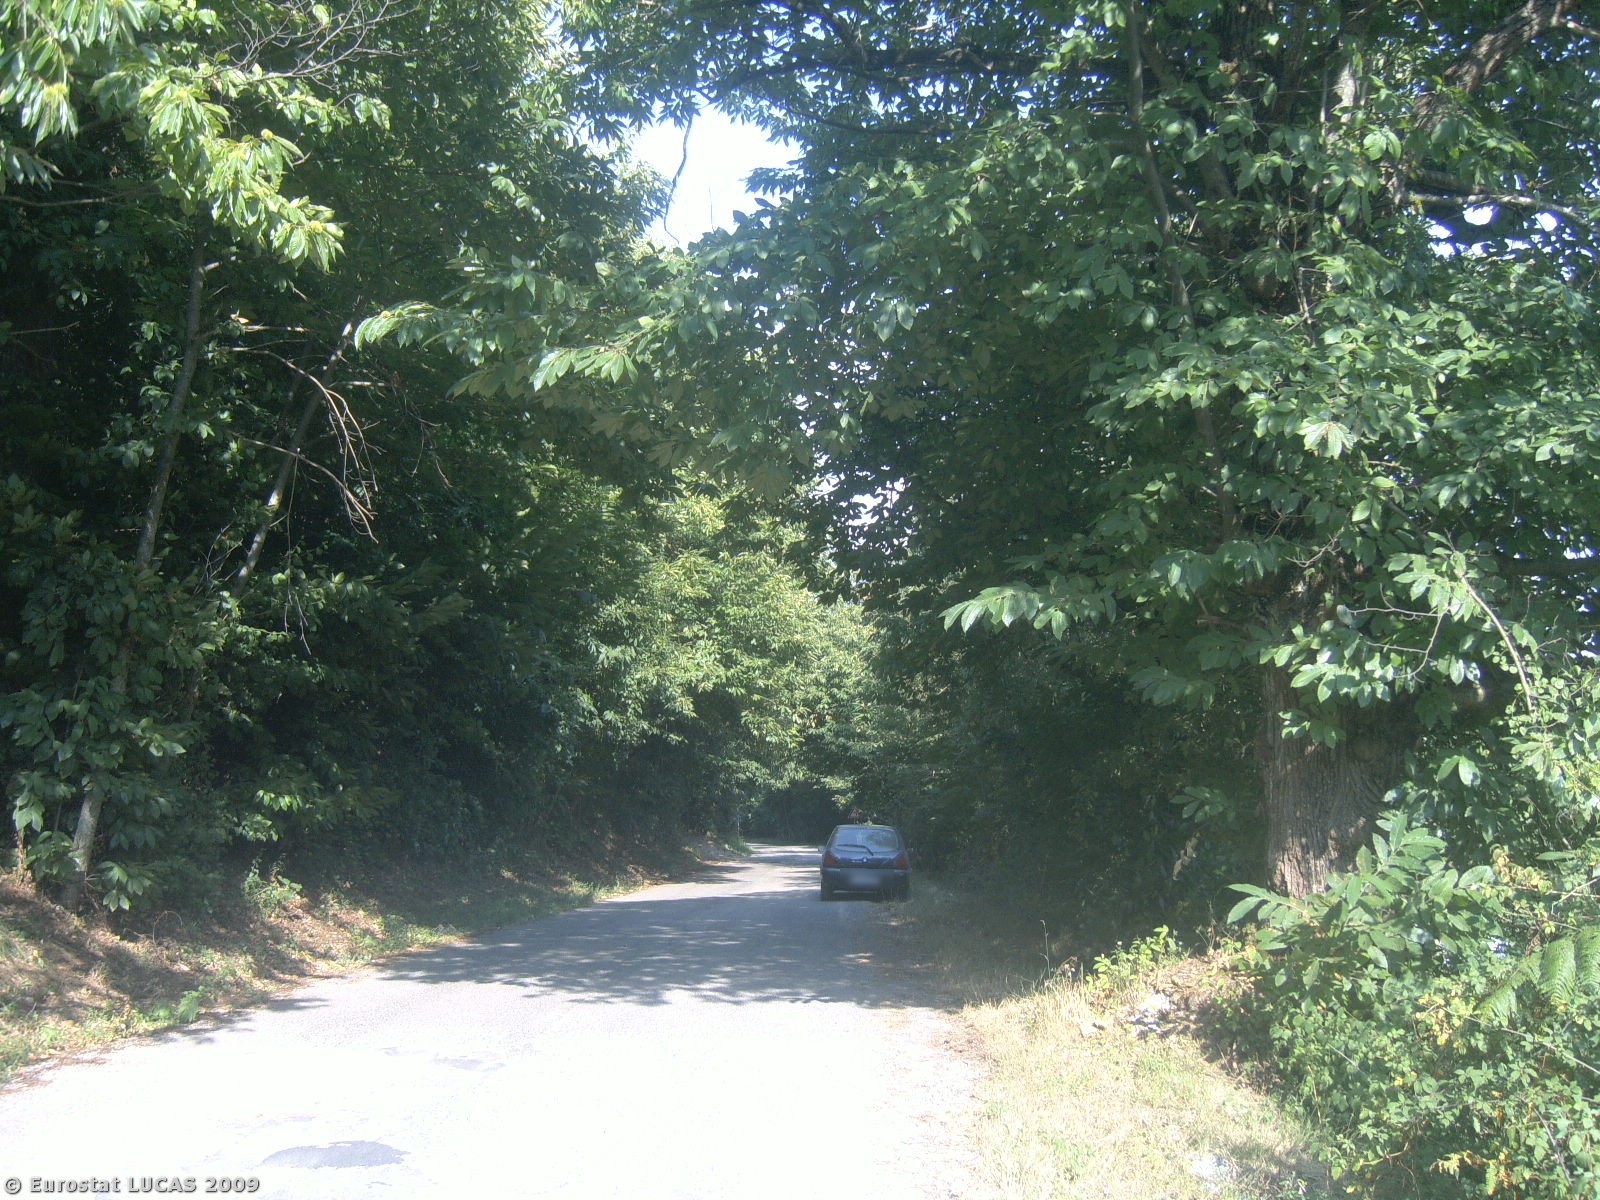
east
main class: Woodland
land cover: Broadleaved woodland
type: thermophilous deciduous forest
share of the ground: > 75 %
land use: Forestry
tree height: > 5 m
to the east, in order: Broadleaved woodland
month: July
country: IT
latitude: 41.7899
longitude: 13.2011
